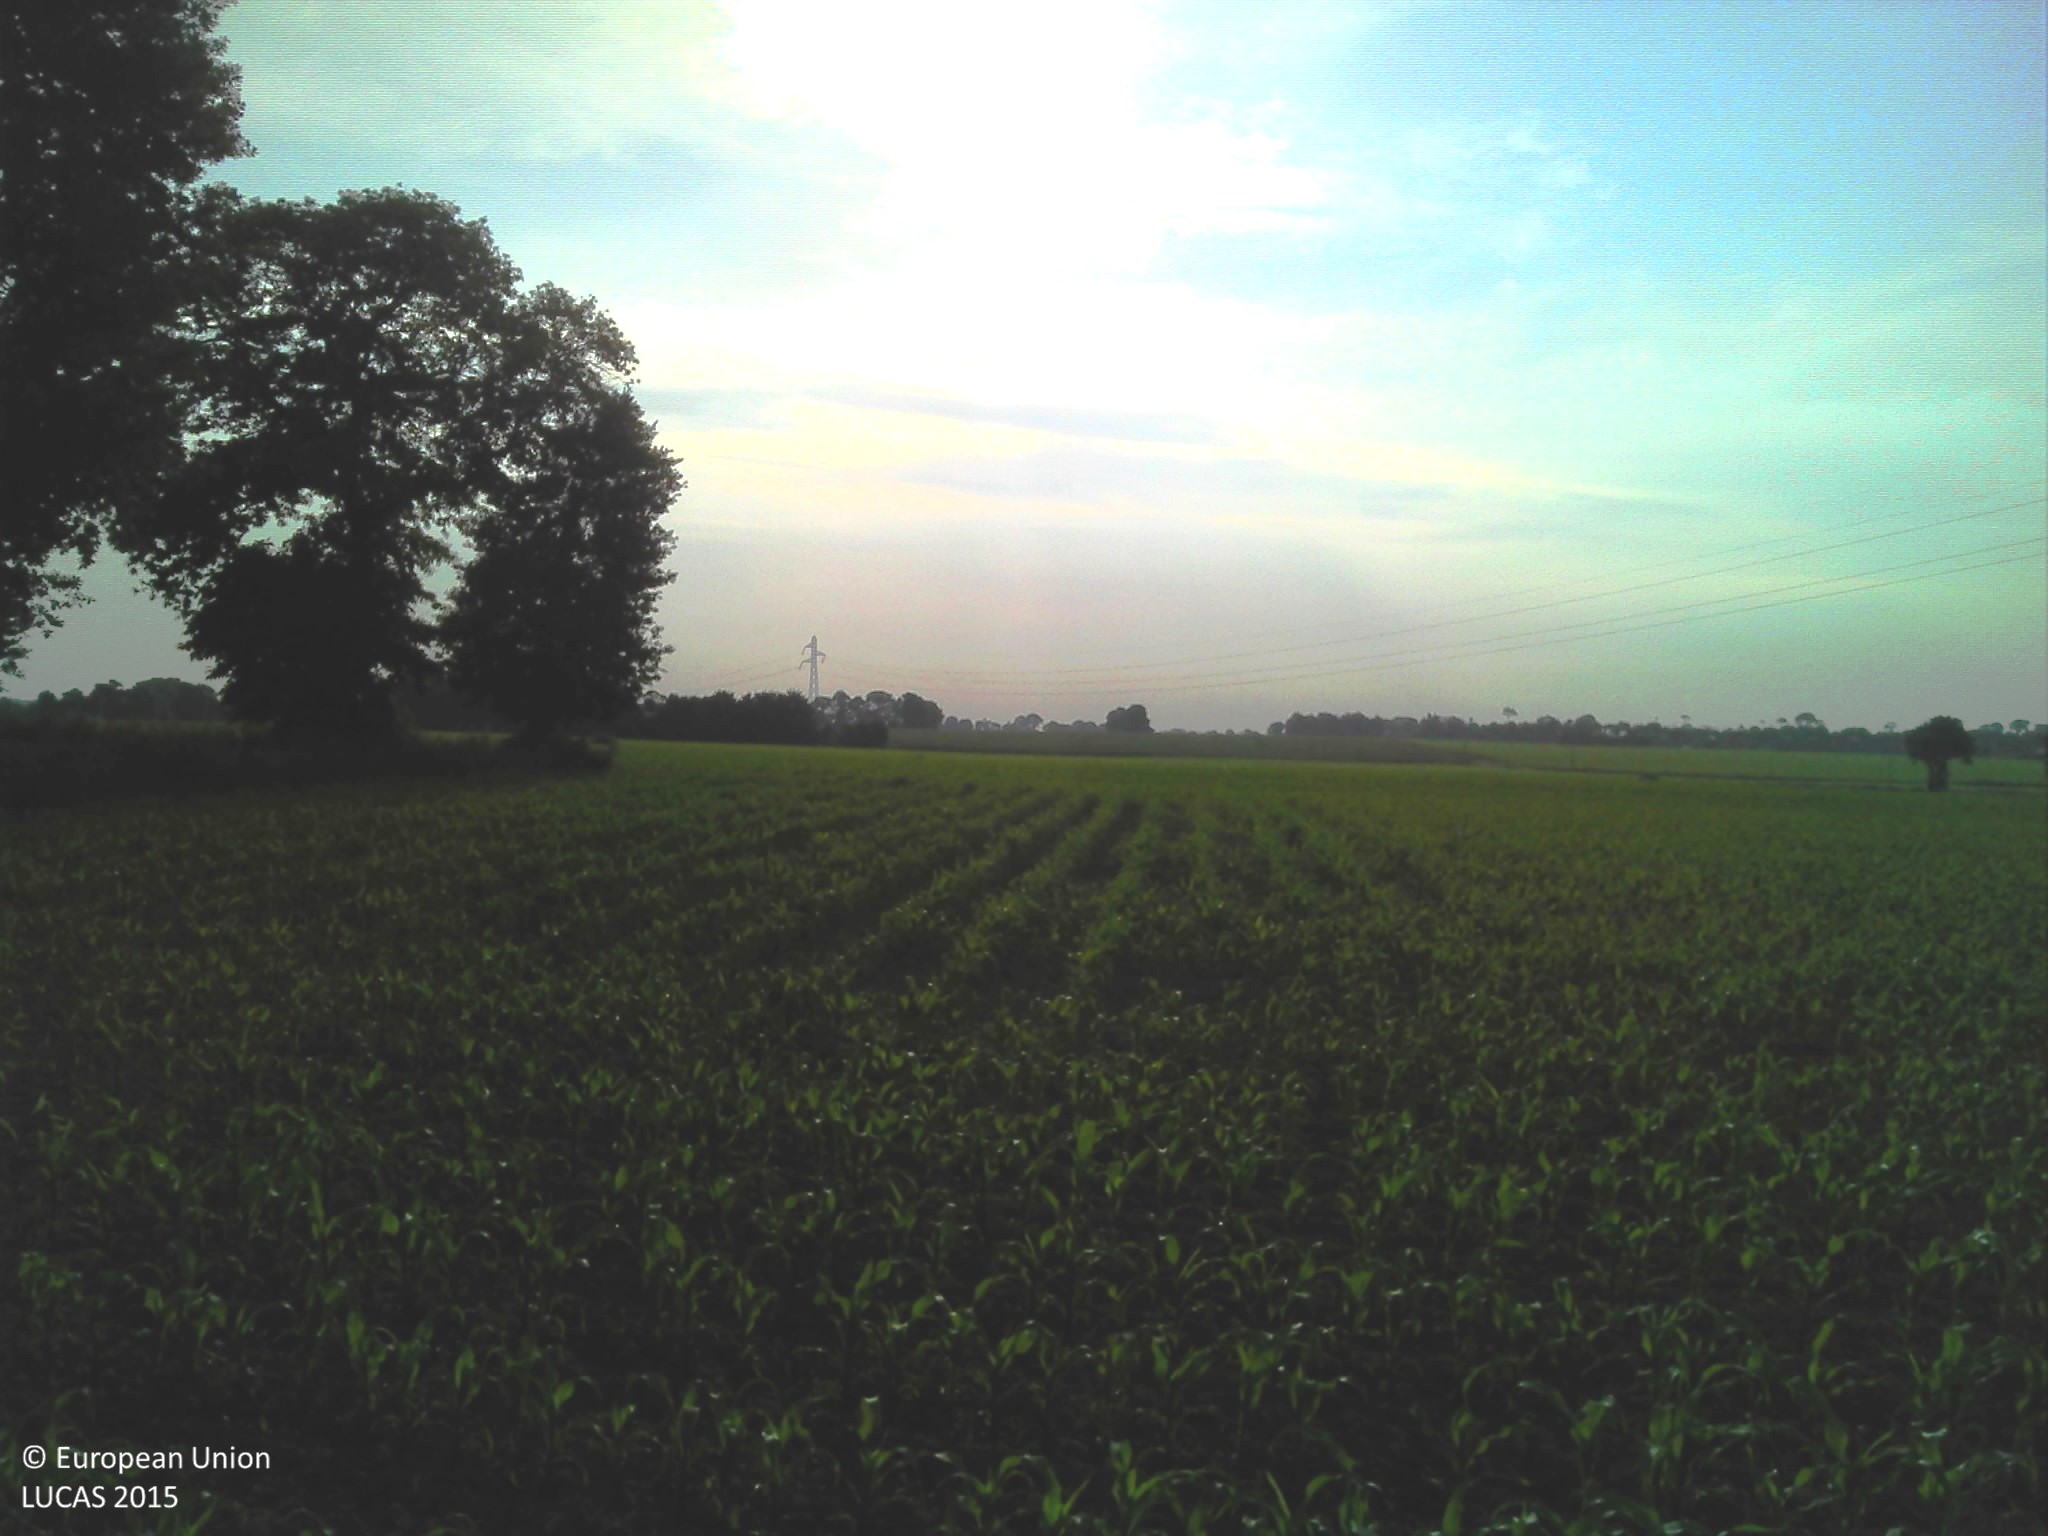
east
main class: Cropland
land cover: Maize
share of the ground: 25 - 50 %
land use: Agriculture (excluding fallow land and kitchen gardens)
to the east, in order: Maize; Electric lines; Maize; Ditches and canals; Maize
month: June
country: FR
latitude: 48.1559
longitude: -1.9218
